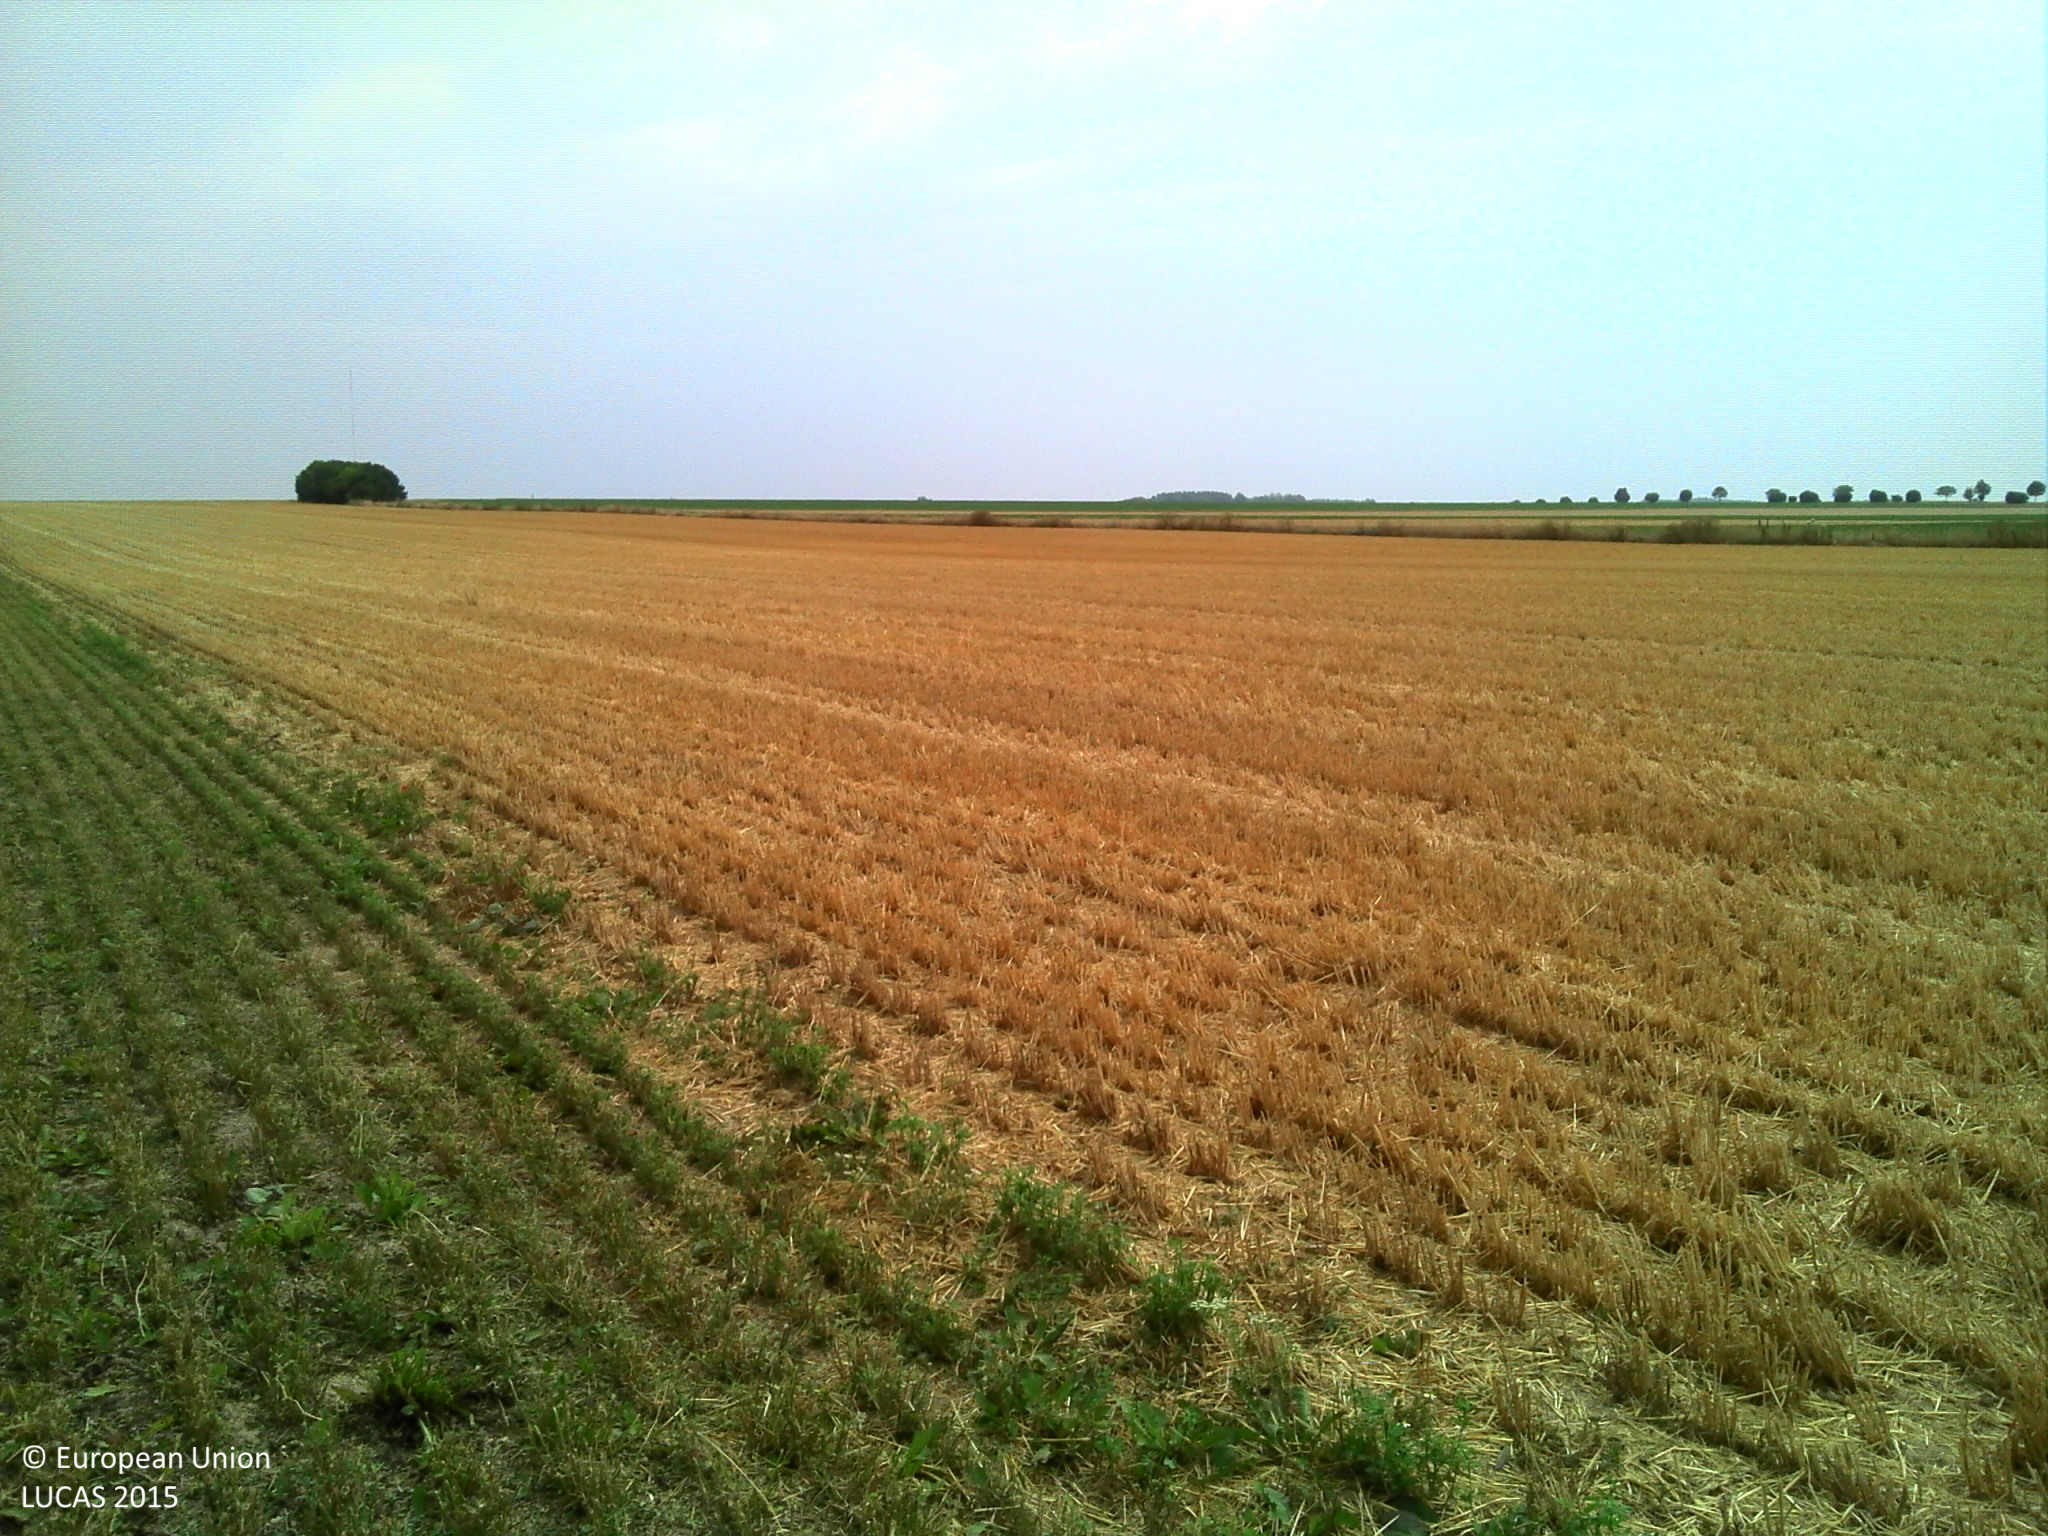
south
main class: Cropland
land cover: Lucerne
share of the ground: > 75 %
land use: Agriculture (excluding fallow land and kitchen gardens)
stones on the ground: < 10 %
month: August
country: FR
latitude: 48.6262
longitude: 3.7946
